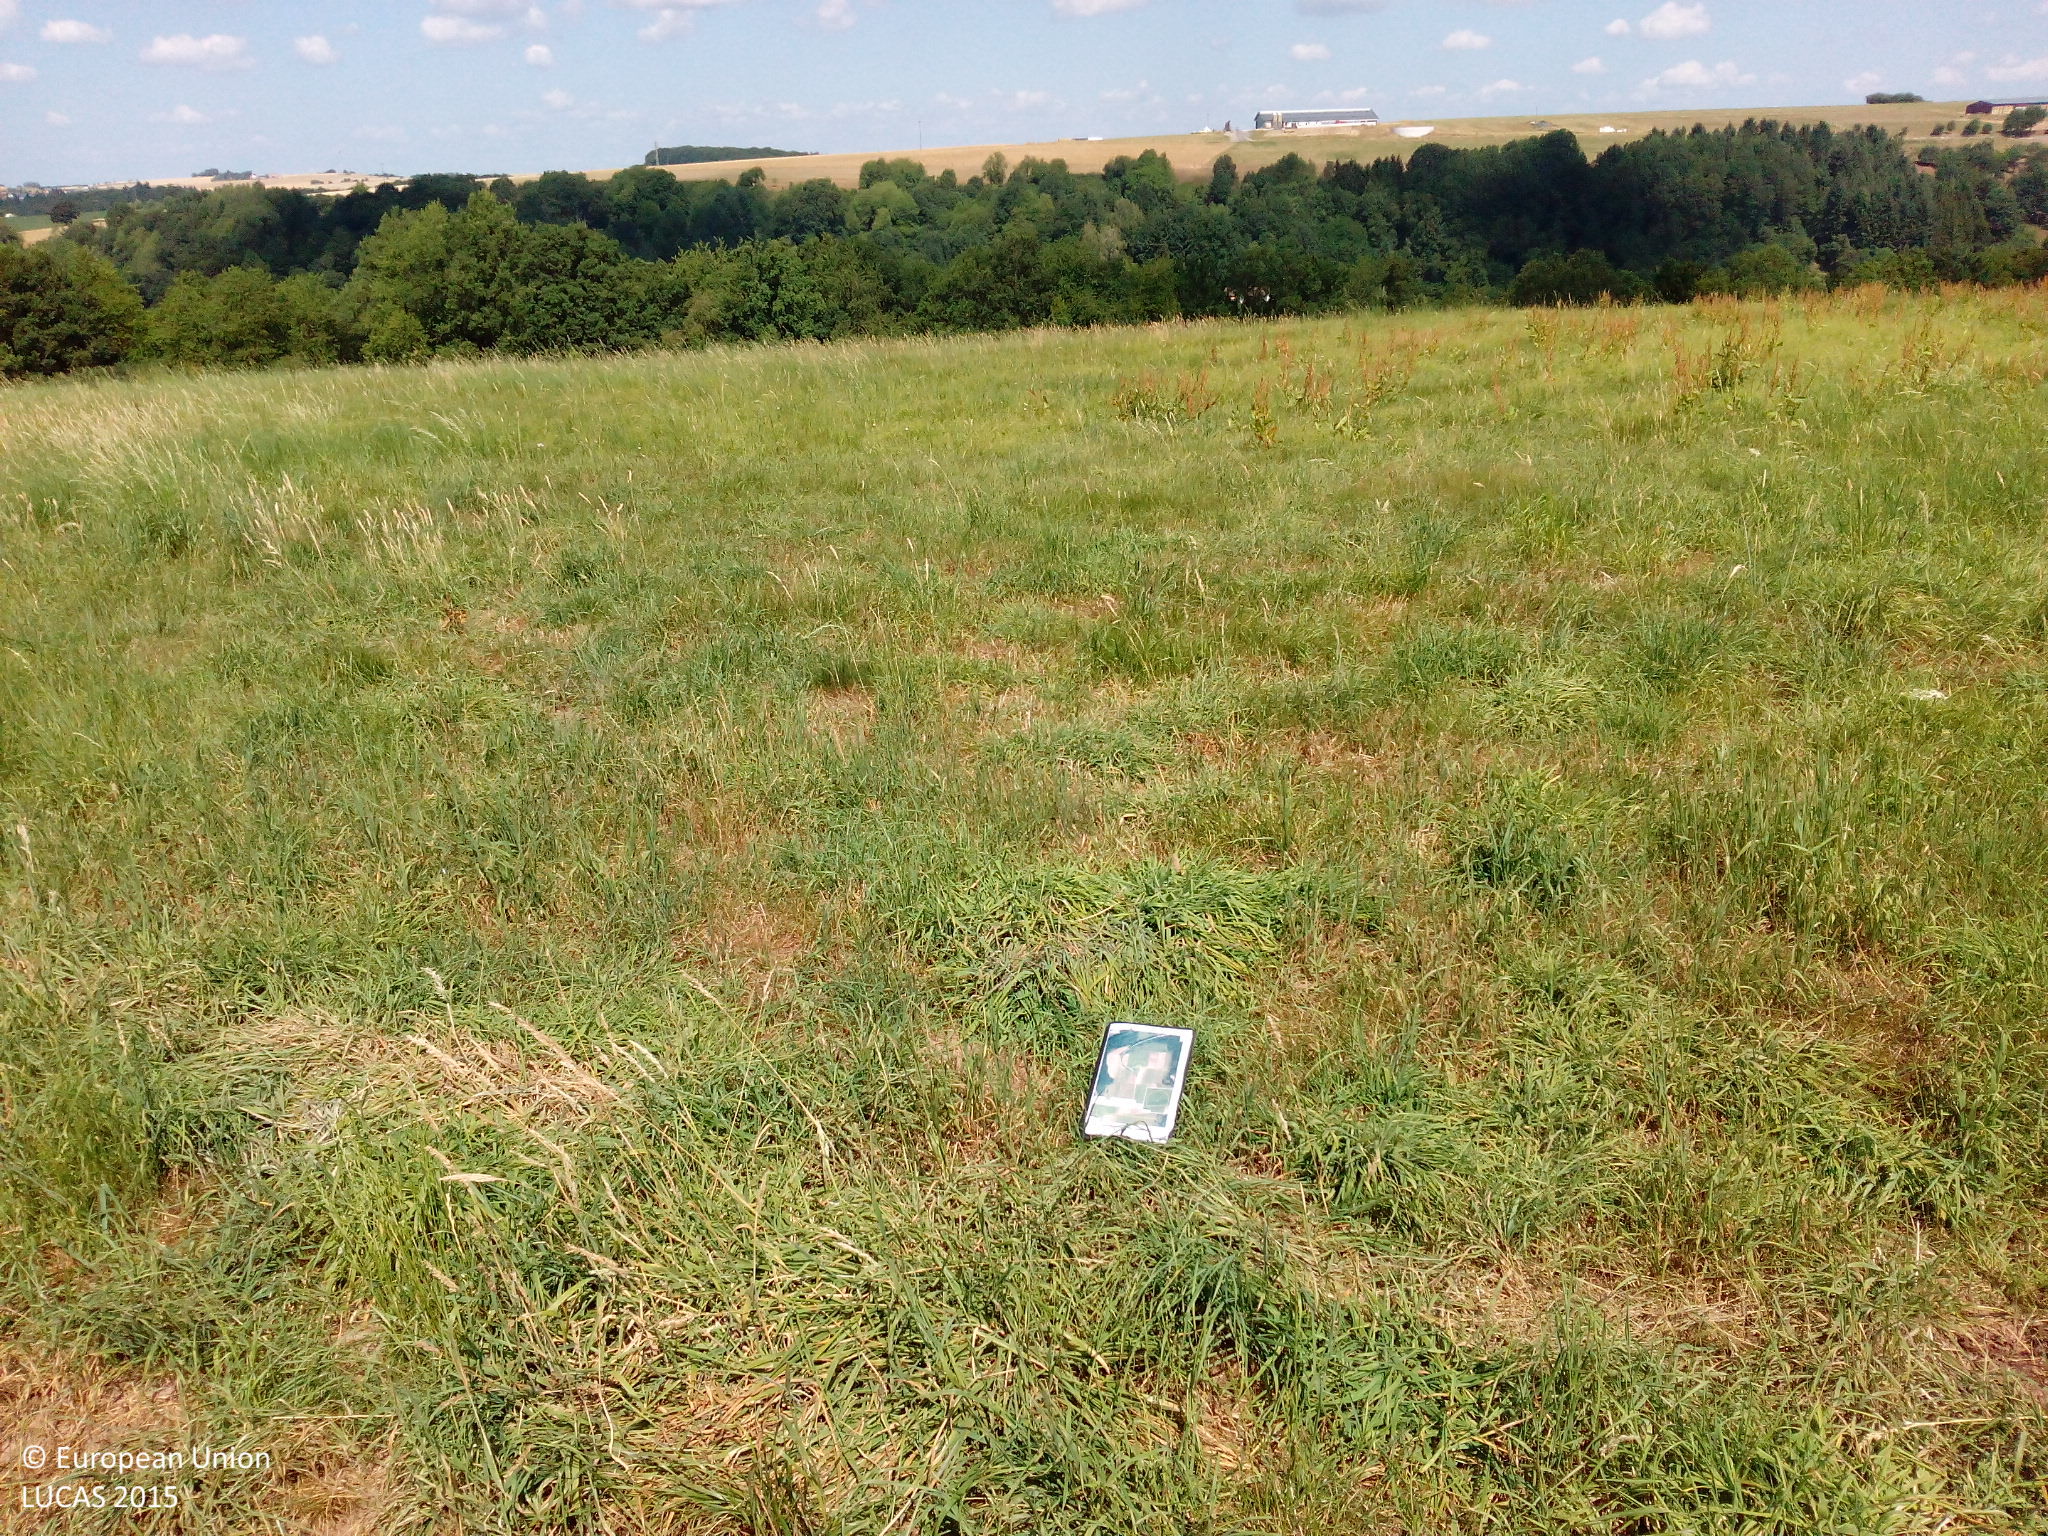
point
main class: Grassland
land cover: Grassland without tree/shrub cover
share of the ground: > 75 %
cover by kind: herbaceous plants 85 %, unconsolidated bare surface 15 %
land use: Agriculture (excluding fallow land and kitchen gardens)
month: July
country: DE
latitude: 49.2587
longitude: 7.5685
